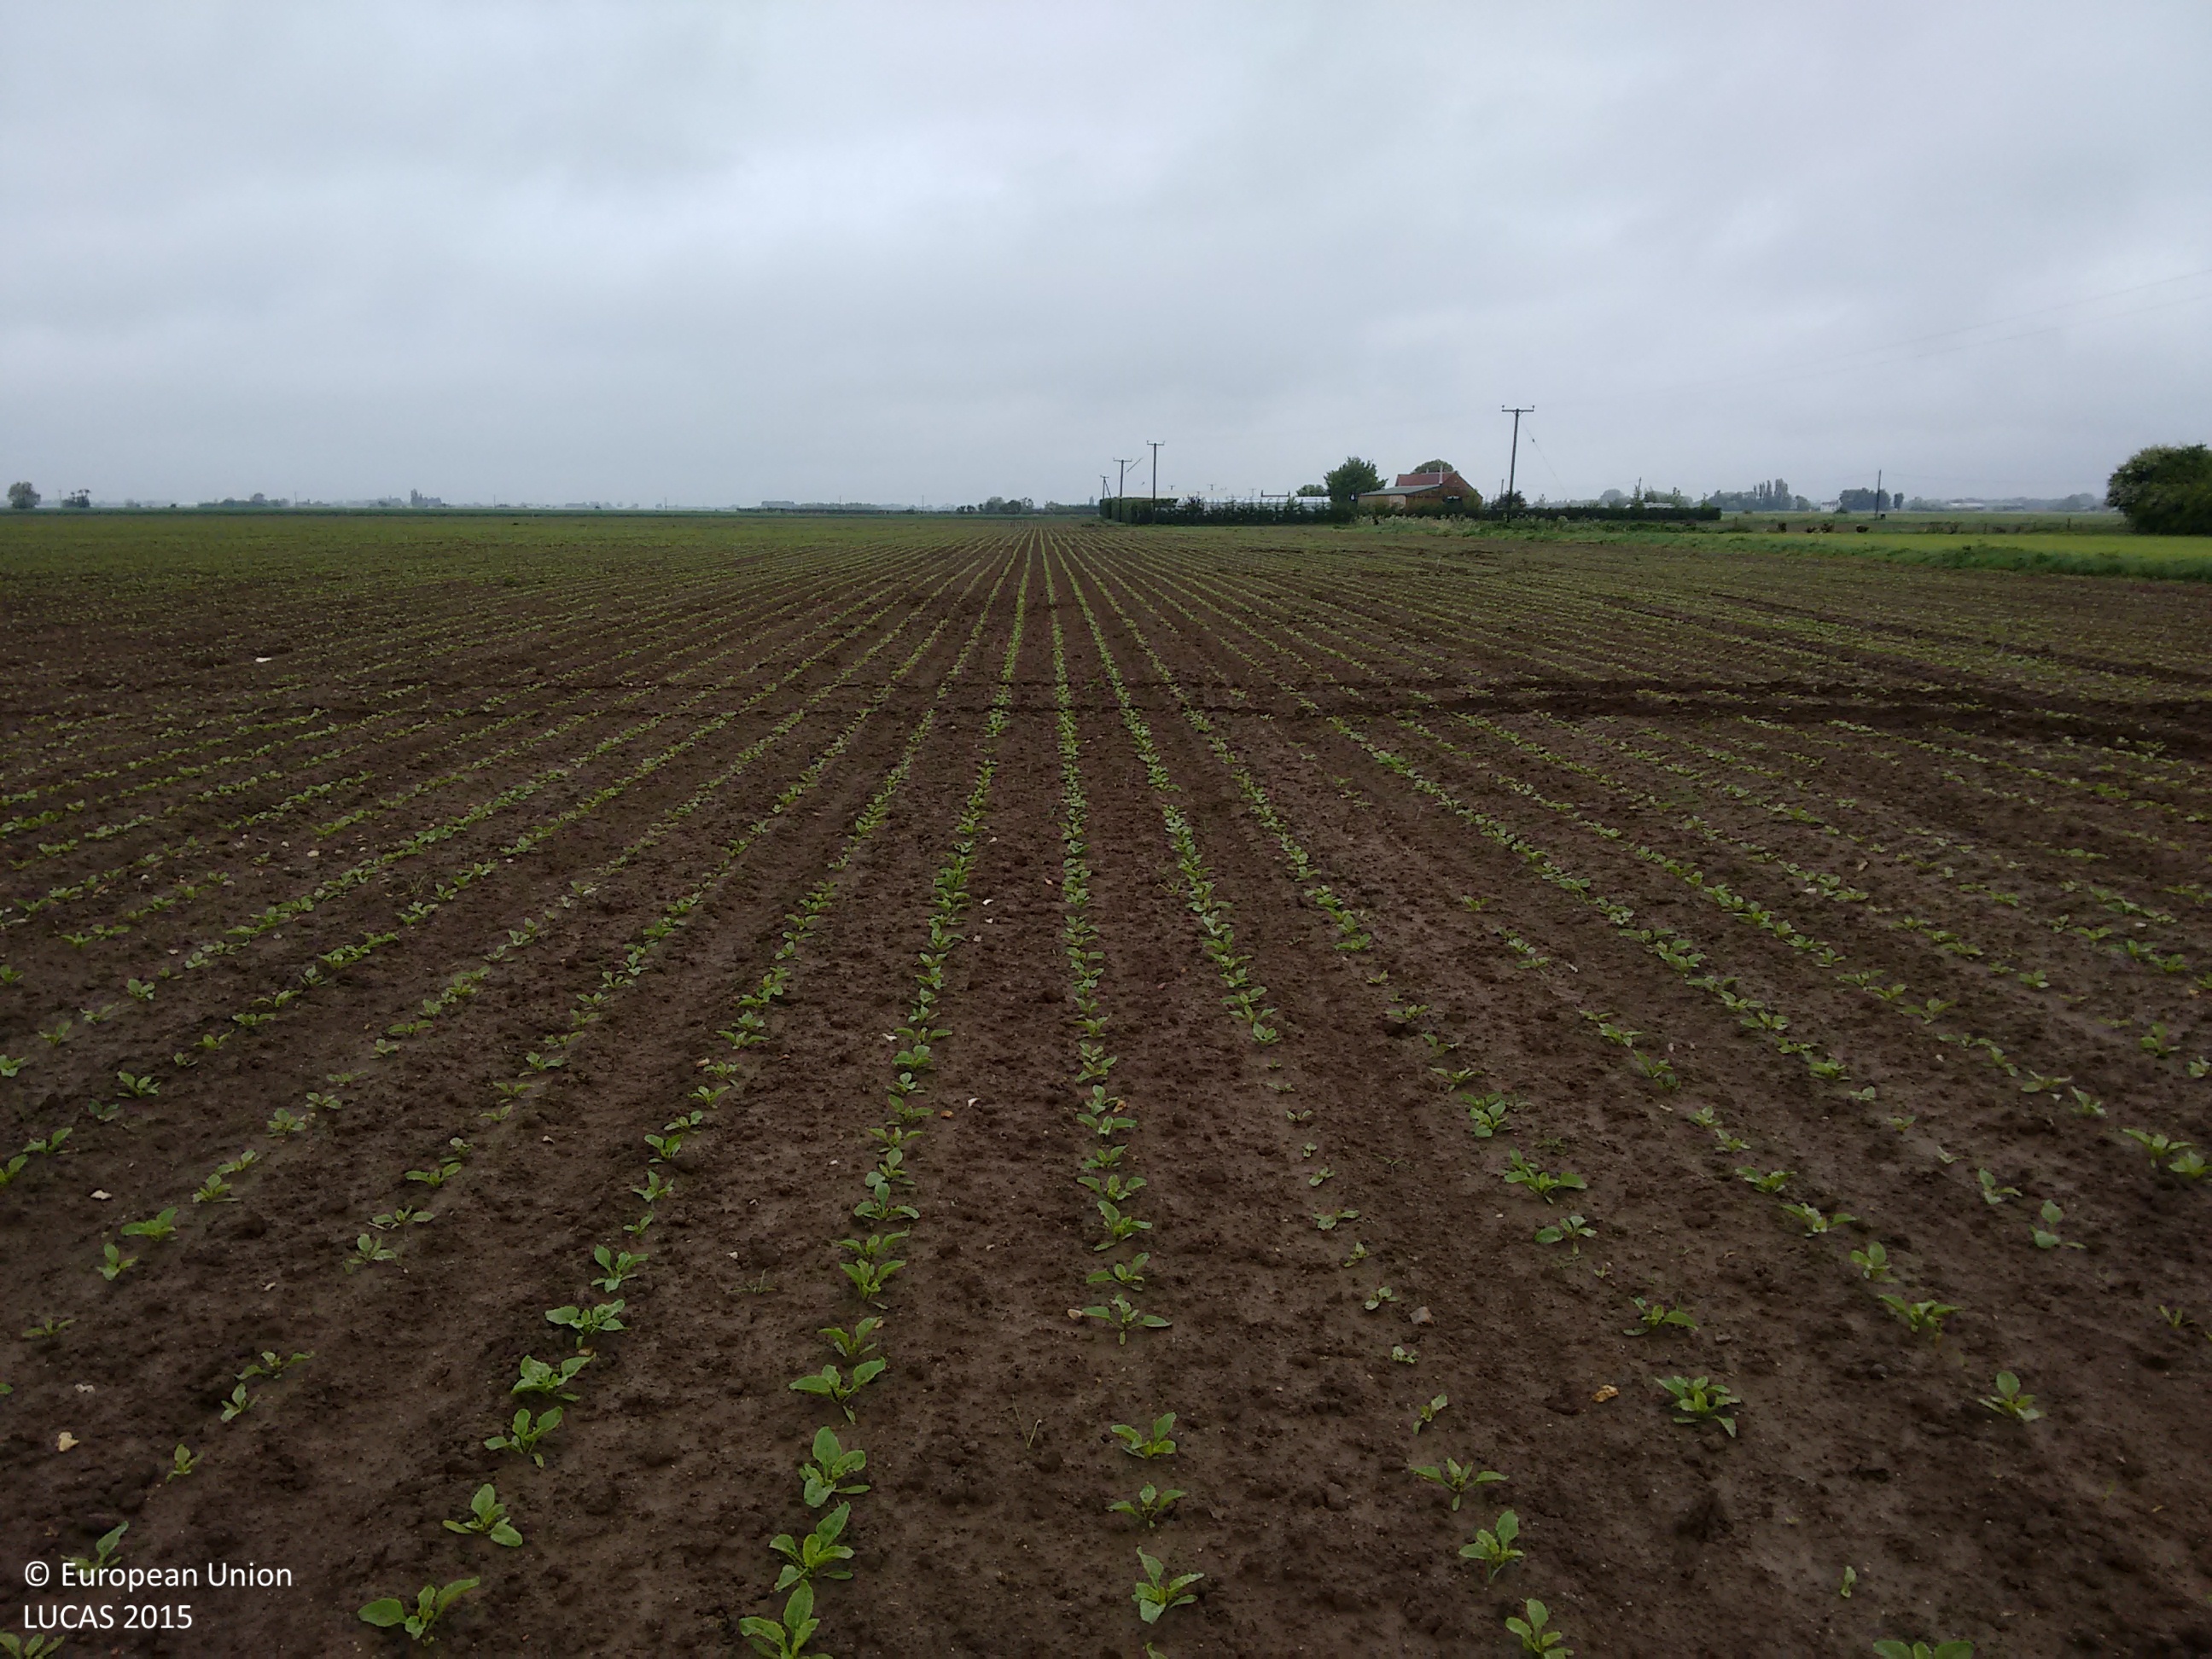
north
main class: Cropland
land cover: Sugar beet
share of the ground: < 10 %
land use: Agriculture (excluding fallow land and kitchen gardens)
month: May
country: GB
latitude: 52.9062
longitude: -0.0992
